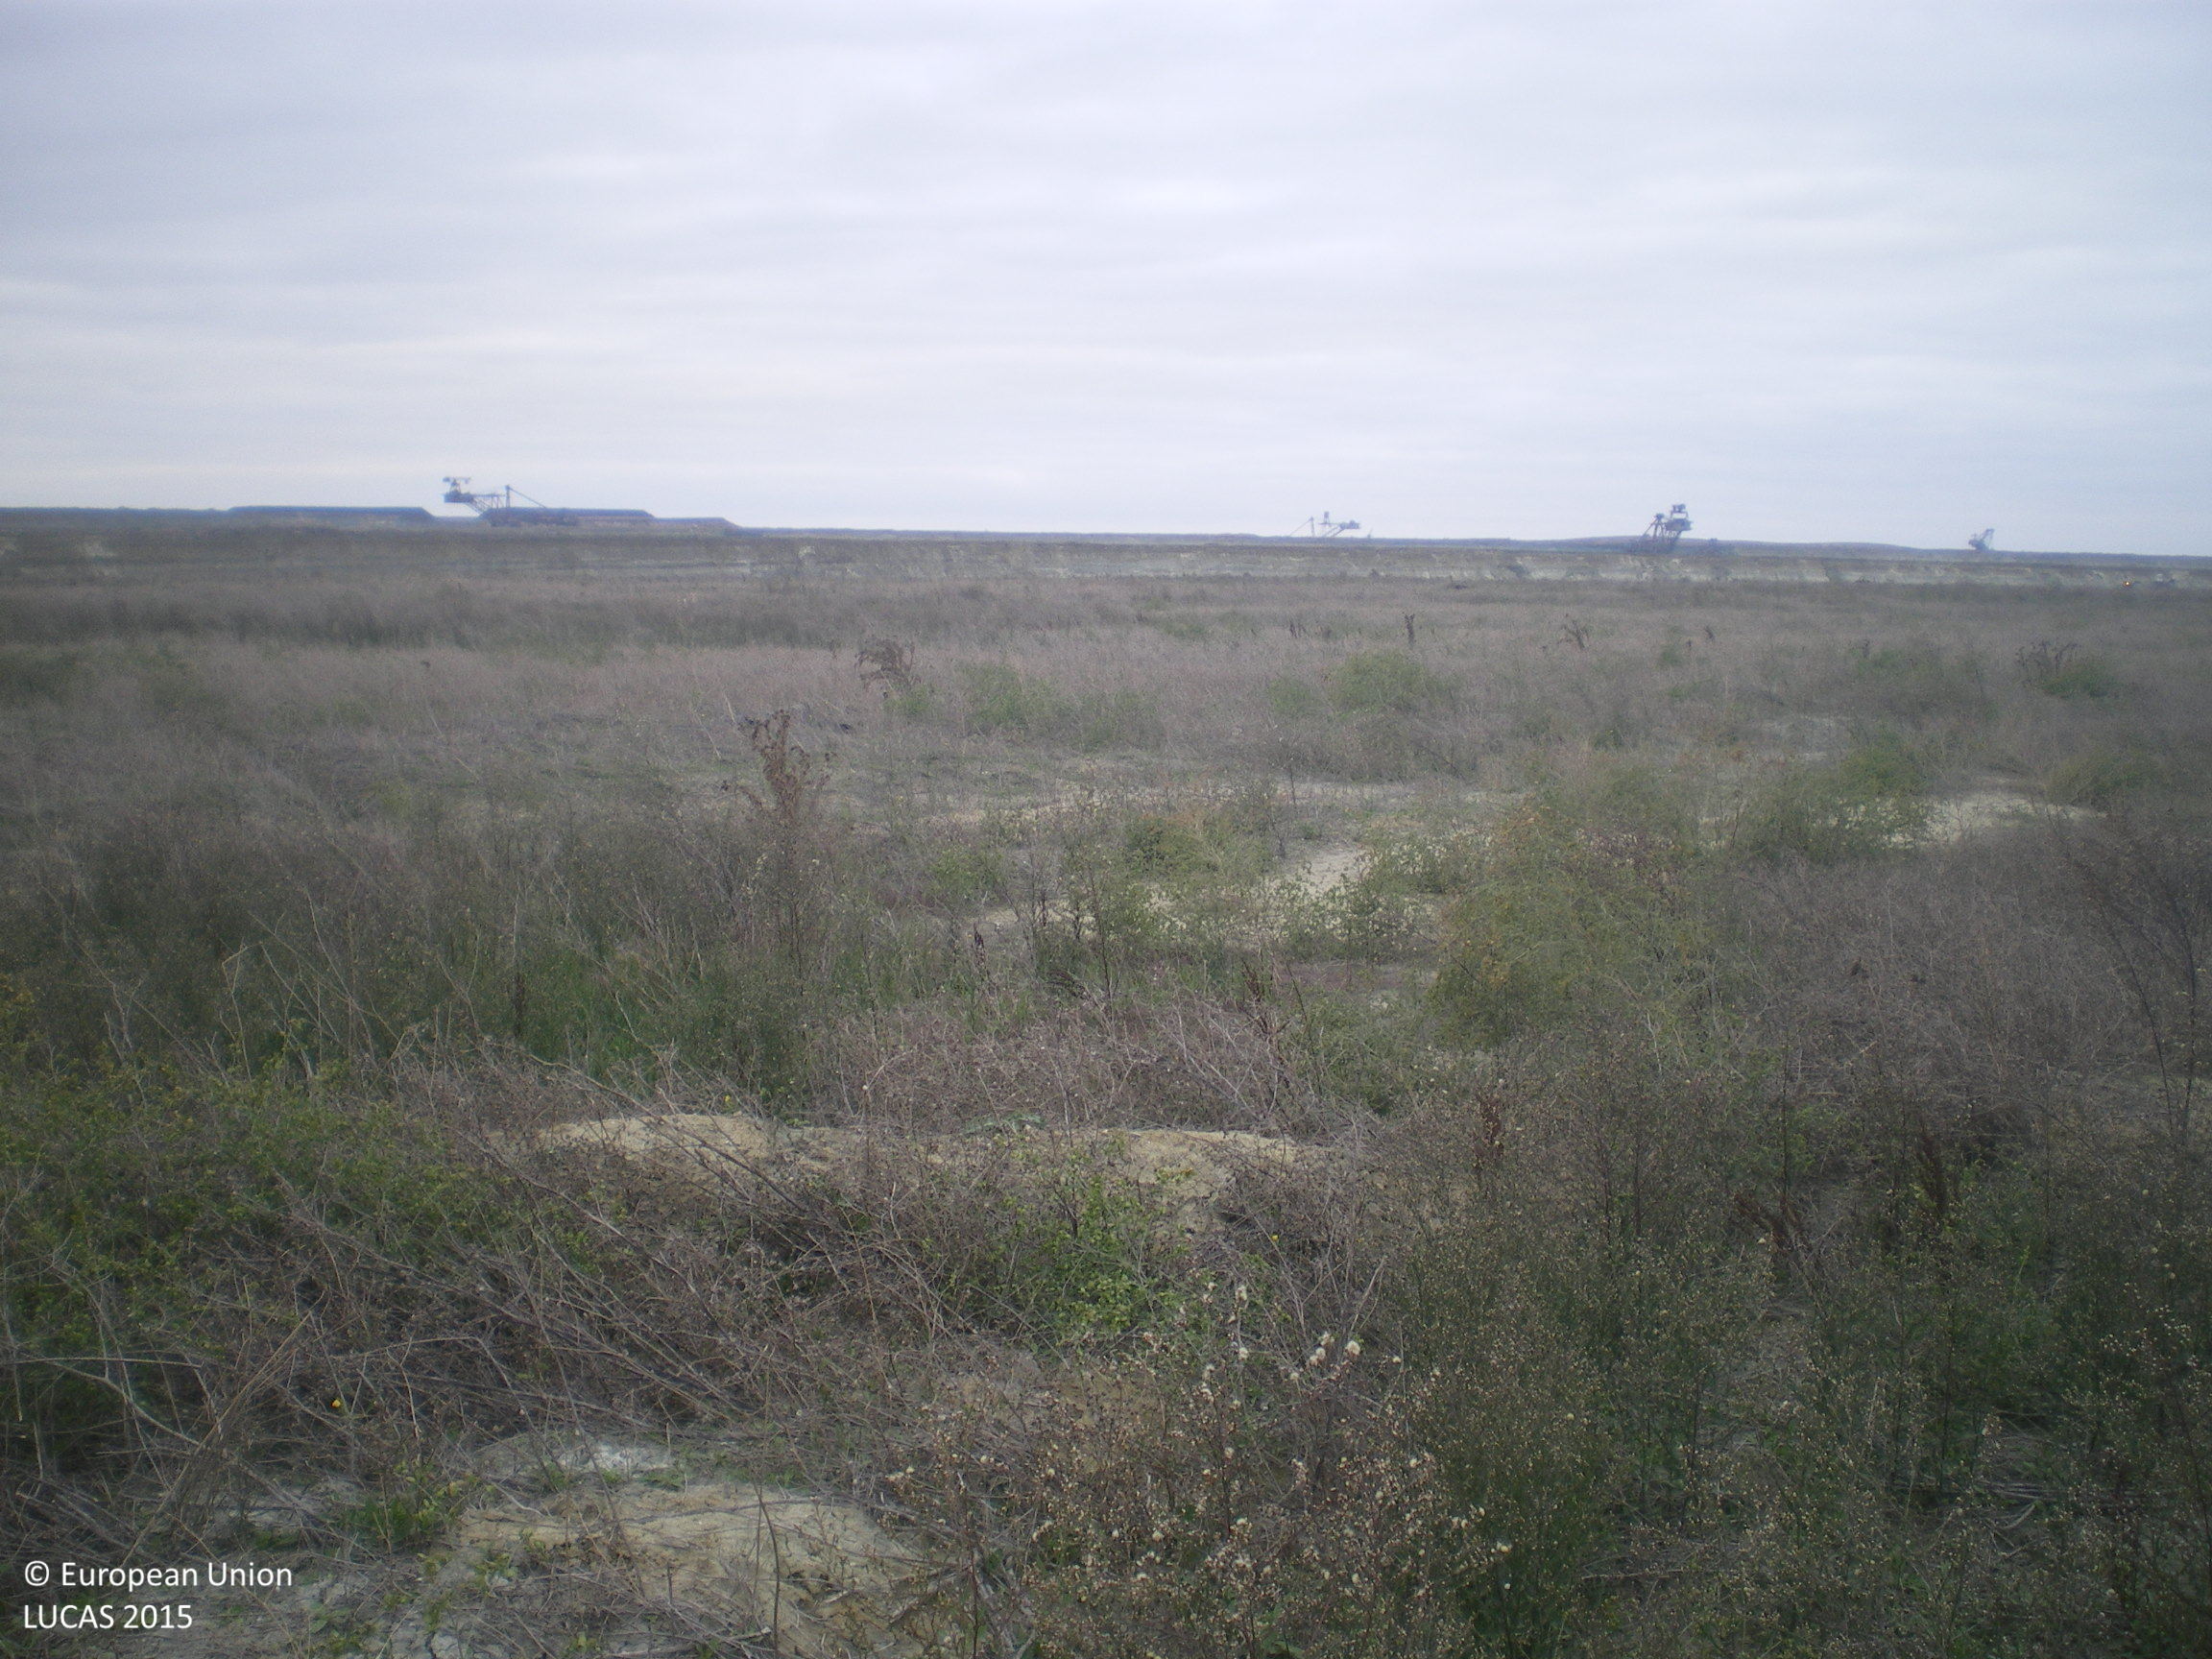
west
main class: Grassland
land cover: Grassland without tree/shrub cover
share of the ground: > 75 %
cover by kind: herbaceous plants 100 %
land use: Mining and quarrying
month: October
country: BG
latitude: 42.2204
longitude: 25.9835
